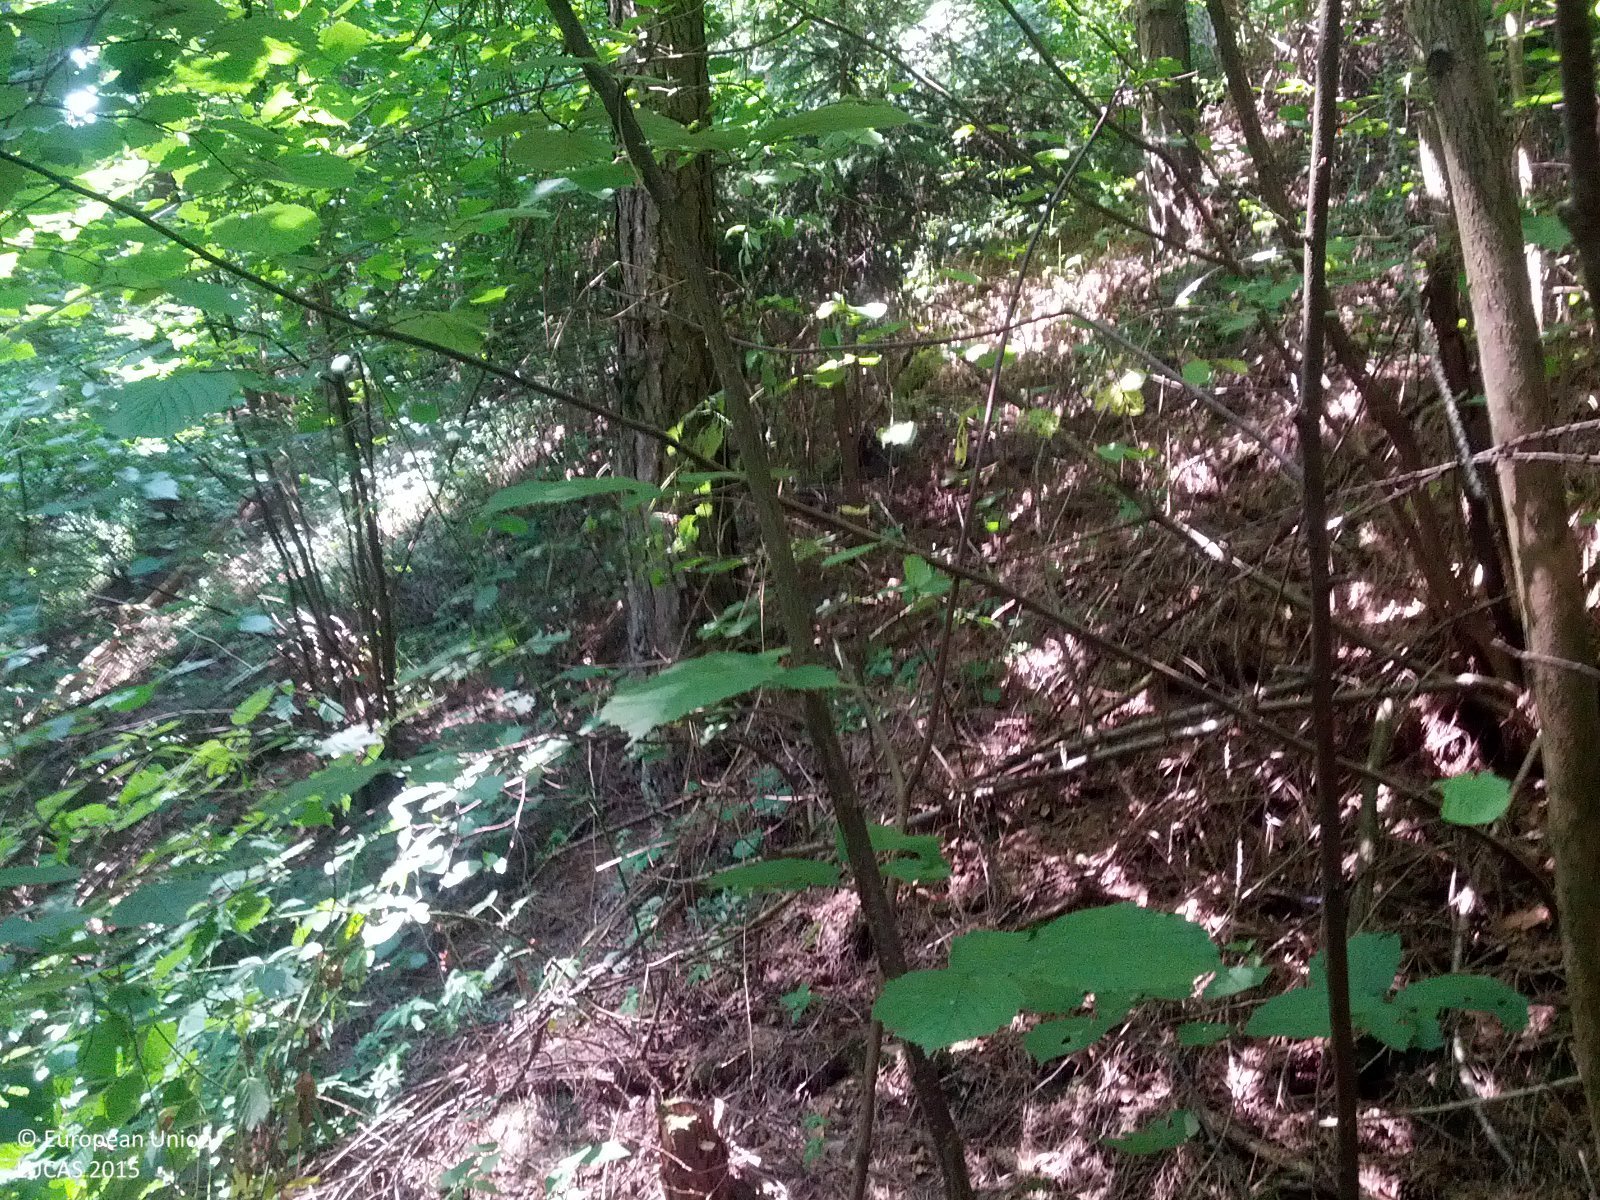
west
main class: Woodland
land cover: Pine dominated mixed woodland
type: hemiboreal forest and nemoral coniferous forest and mixed broadleaved-coniferous forest
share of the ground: > 75 %
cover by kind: coniferous forest trees 65 %, broadleaved forest trees 25 %, shrubs 5 %, herbaceous plants 5 %
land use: Forestry
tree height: > 5 m
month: July
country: AT
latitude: 48.5366
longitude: 16.1943
